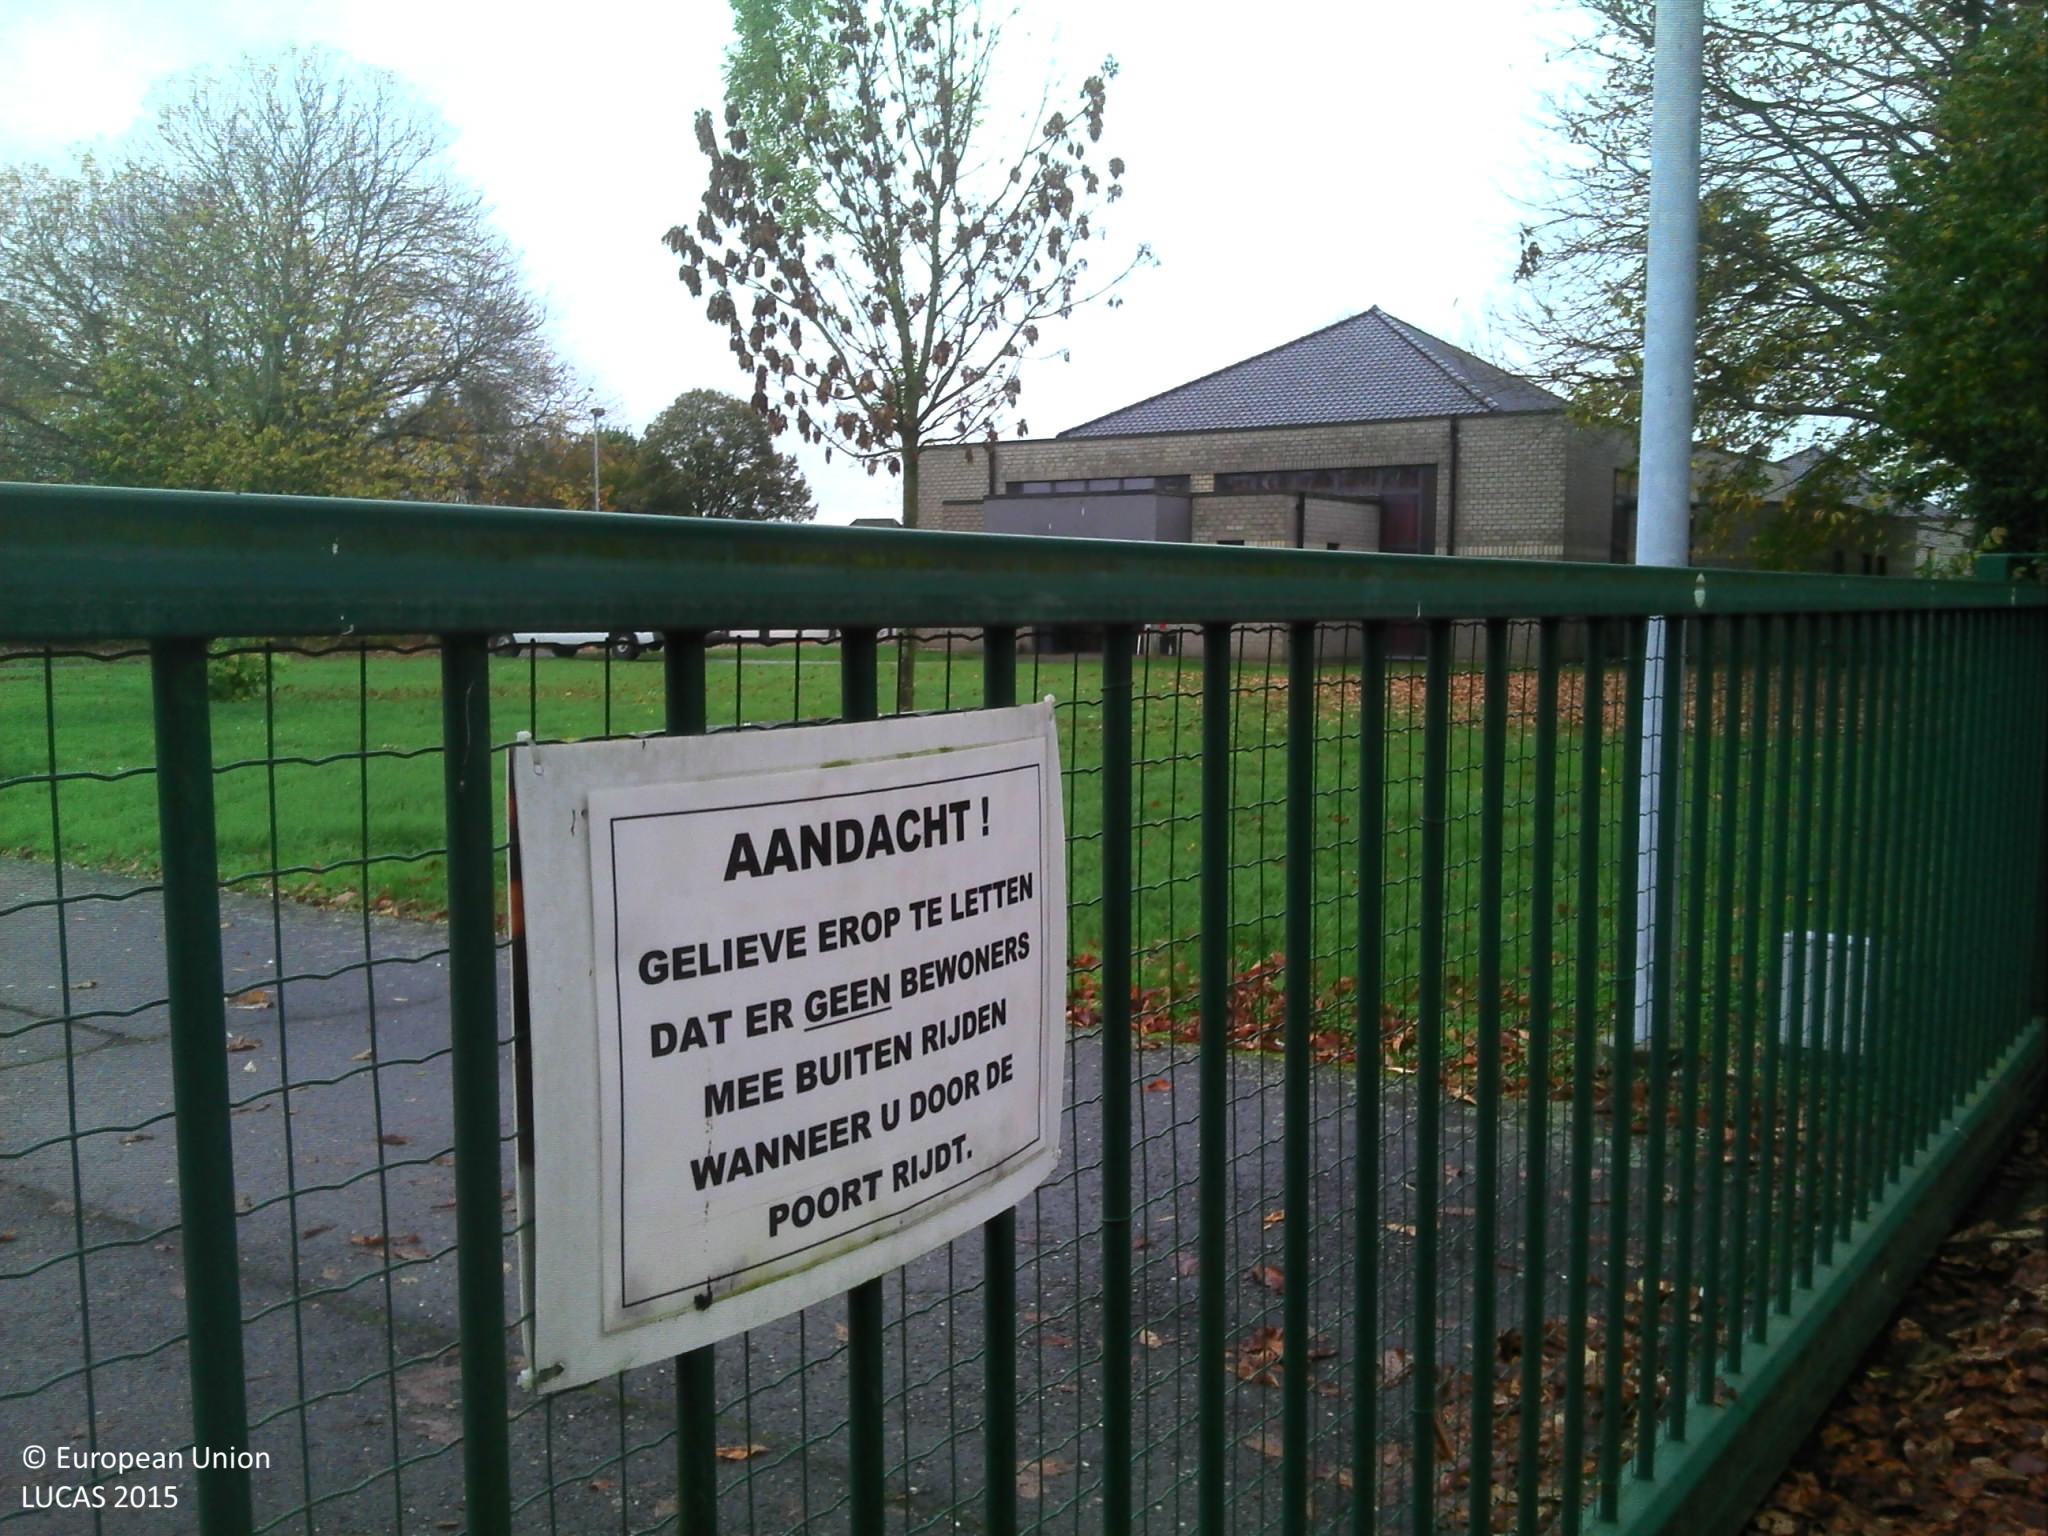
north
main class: Grassland
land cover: Grassland without tree/shrub cover
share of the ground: > 75 %
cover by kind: herbaceous plants 100 %
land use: Residential
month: November
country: BE
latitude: 51.1050
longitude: 4.2966
